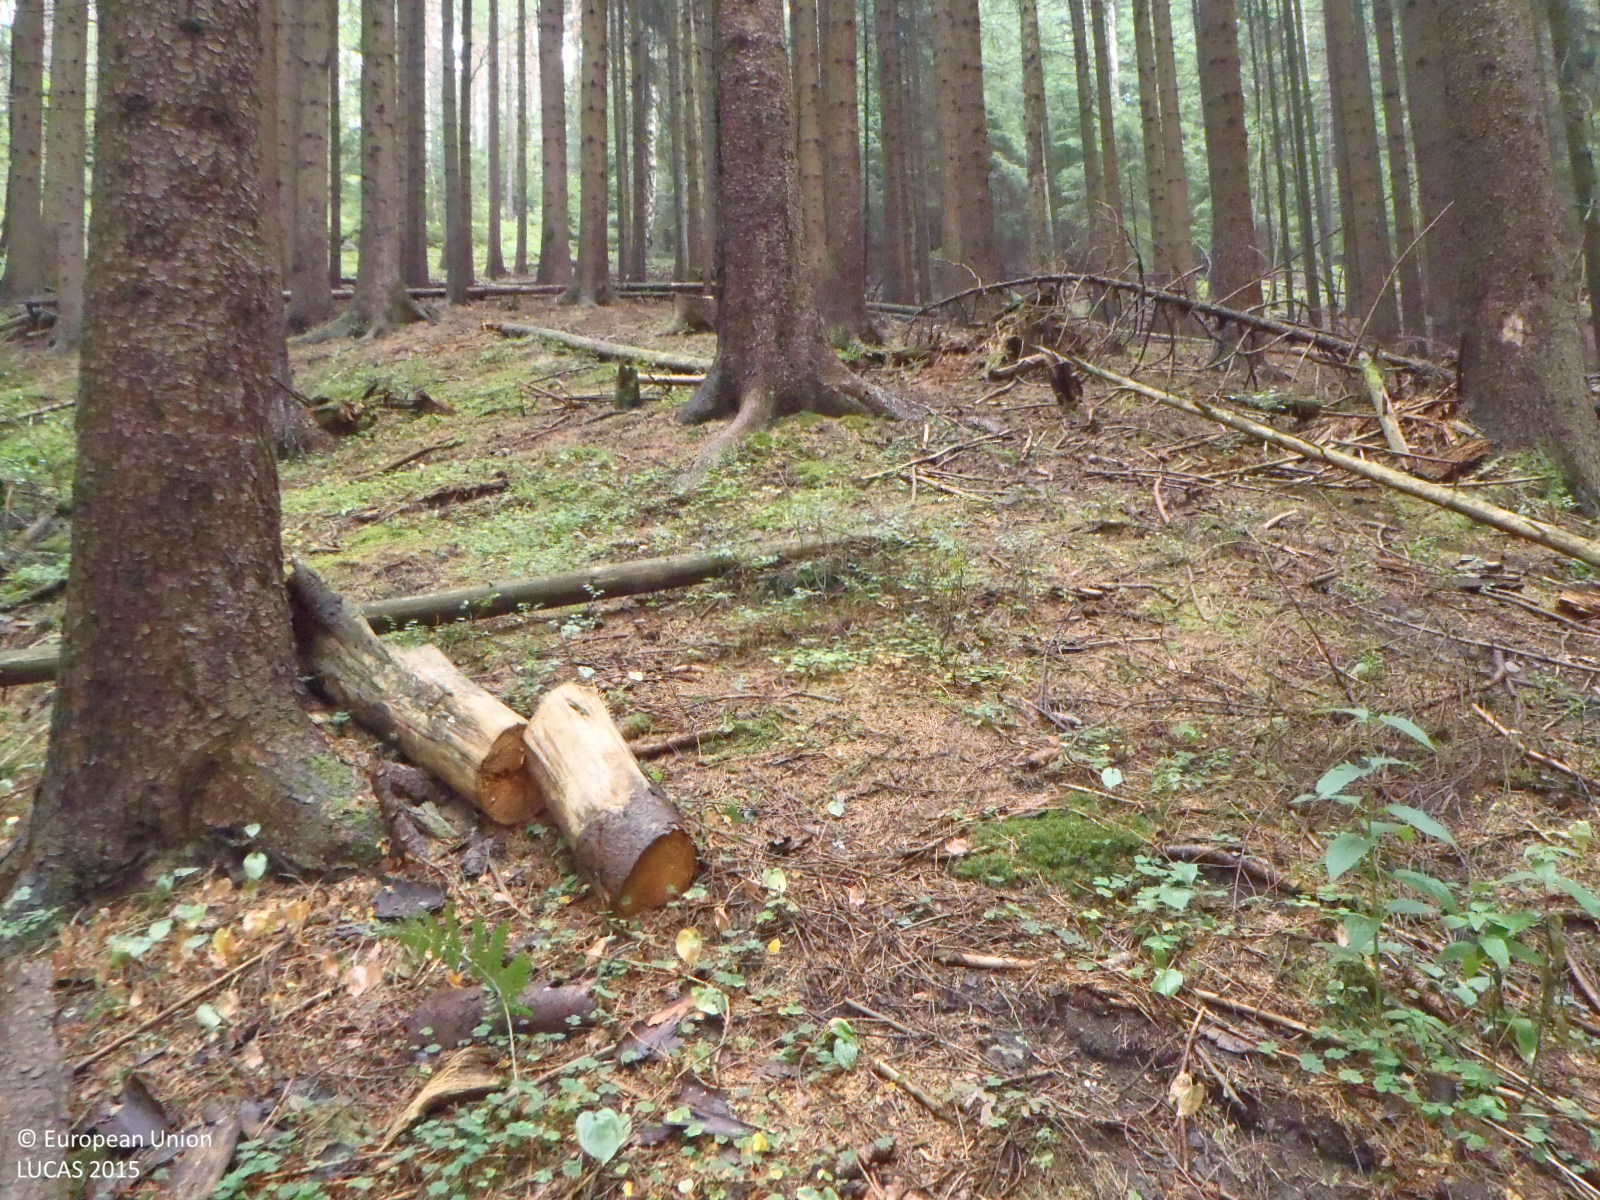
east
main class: Woodland
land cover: Spruce dominated coniferous woodland
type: hemiboreal forest and nemoral coniferous forest and mixed broadleaved-coniferous forest
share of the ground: > 75 %
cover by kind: coniferous forest trees 100 %
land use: Forestry
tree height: > 5 m
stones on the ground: < 10 %
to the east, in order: Spruce dominated coniferous woodland; Other coniferous woodland; Pine dominated coniferous woodland; Tracks; Pine dominated mixed woodland; Fences; Pine dominated mixed woodland
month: August
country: CZ
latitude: 50.6705
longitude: 14.9693
